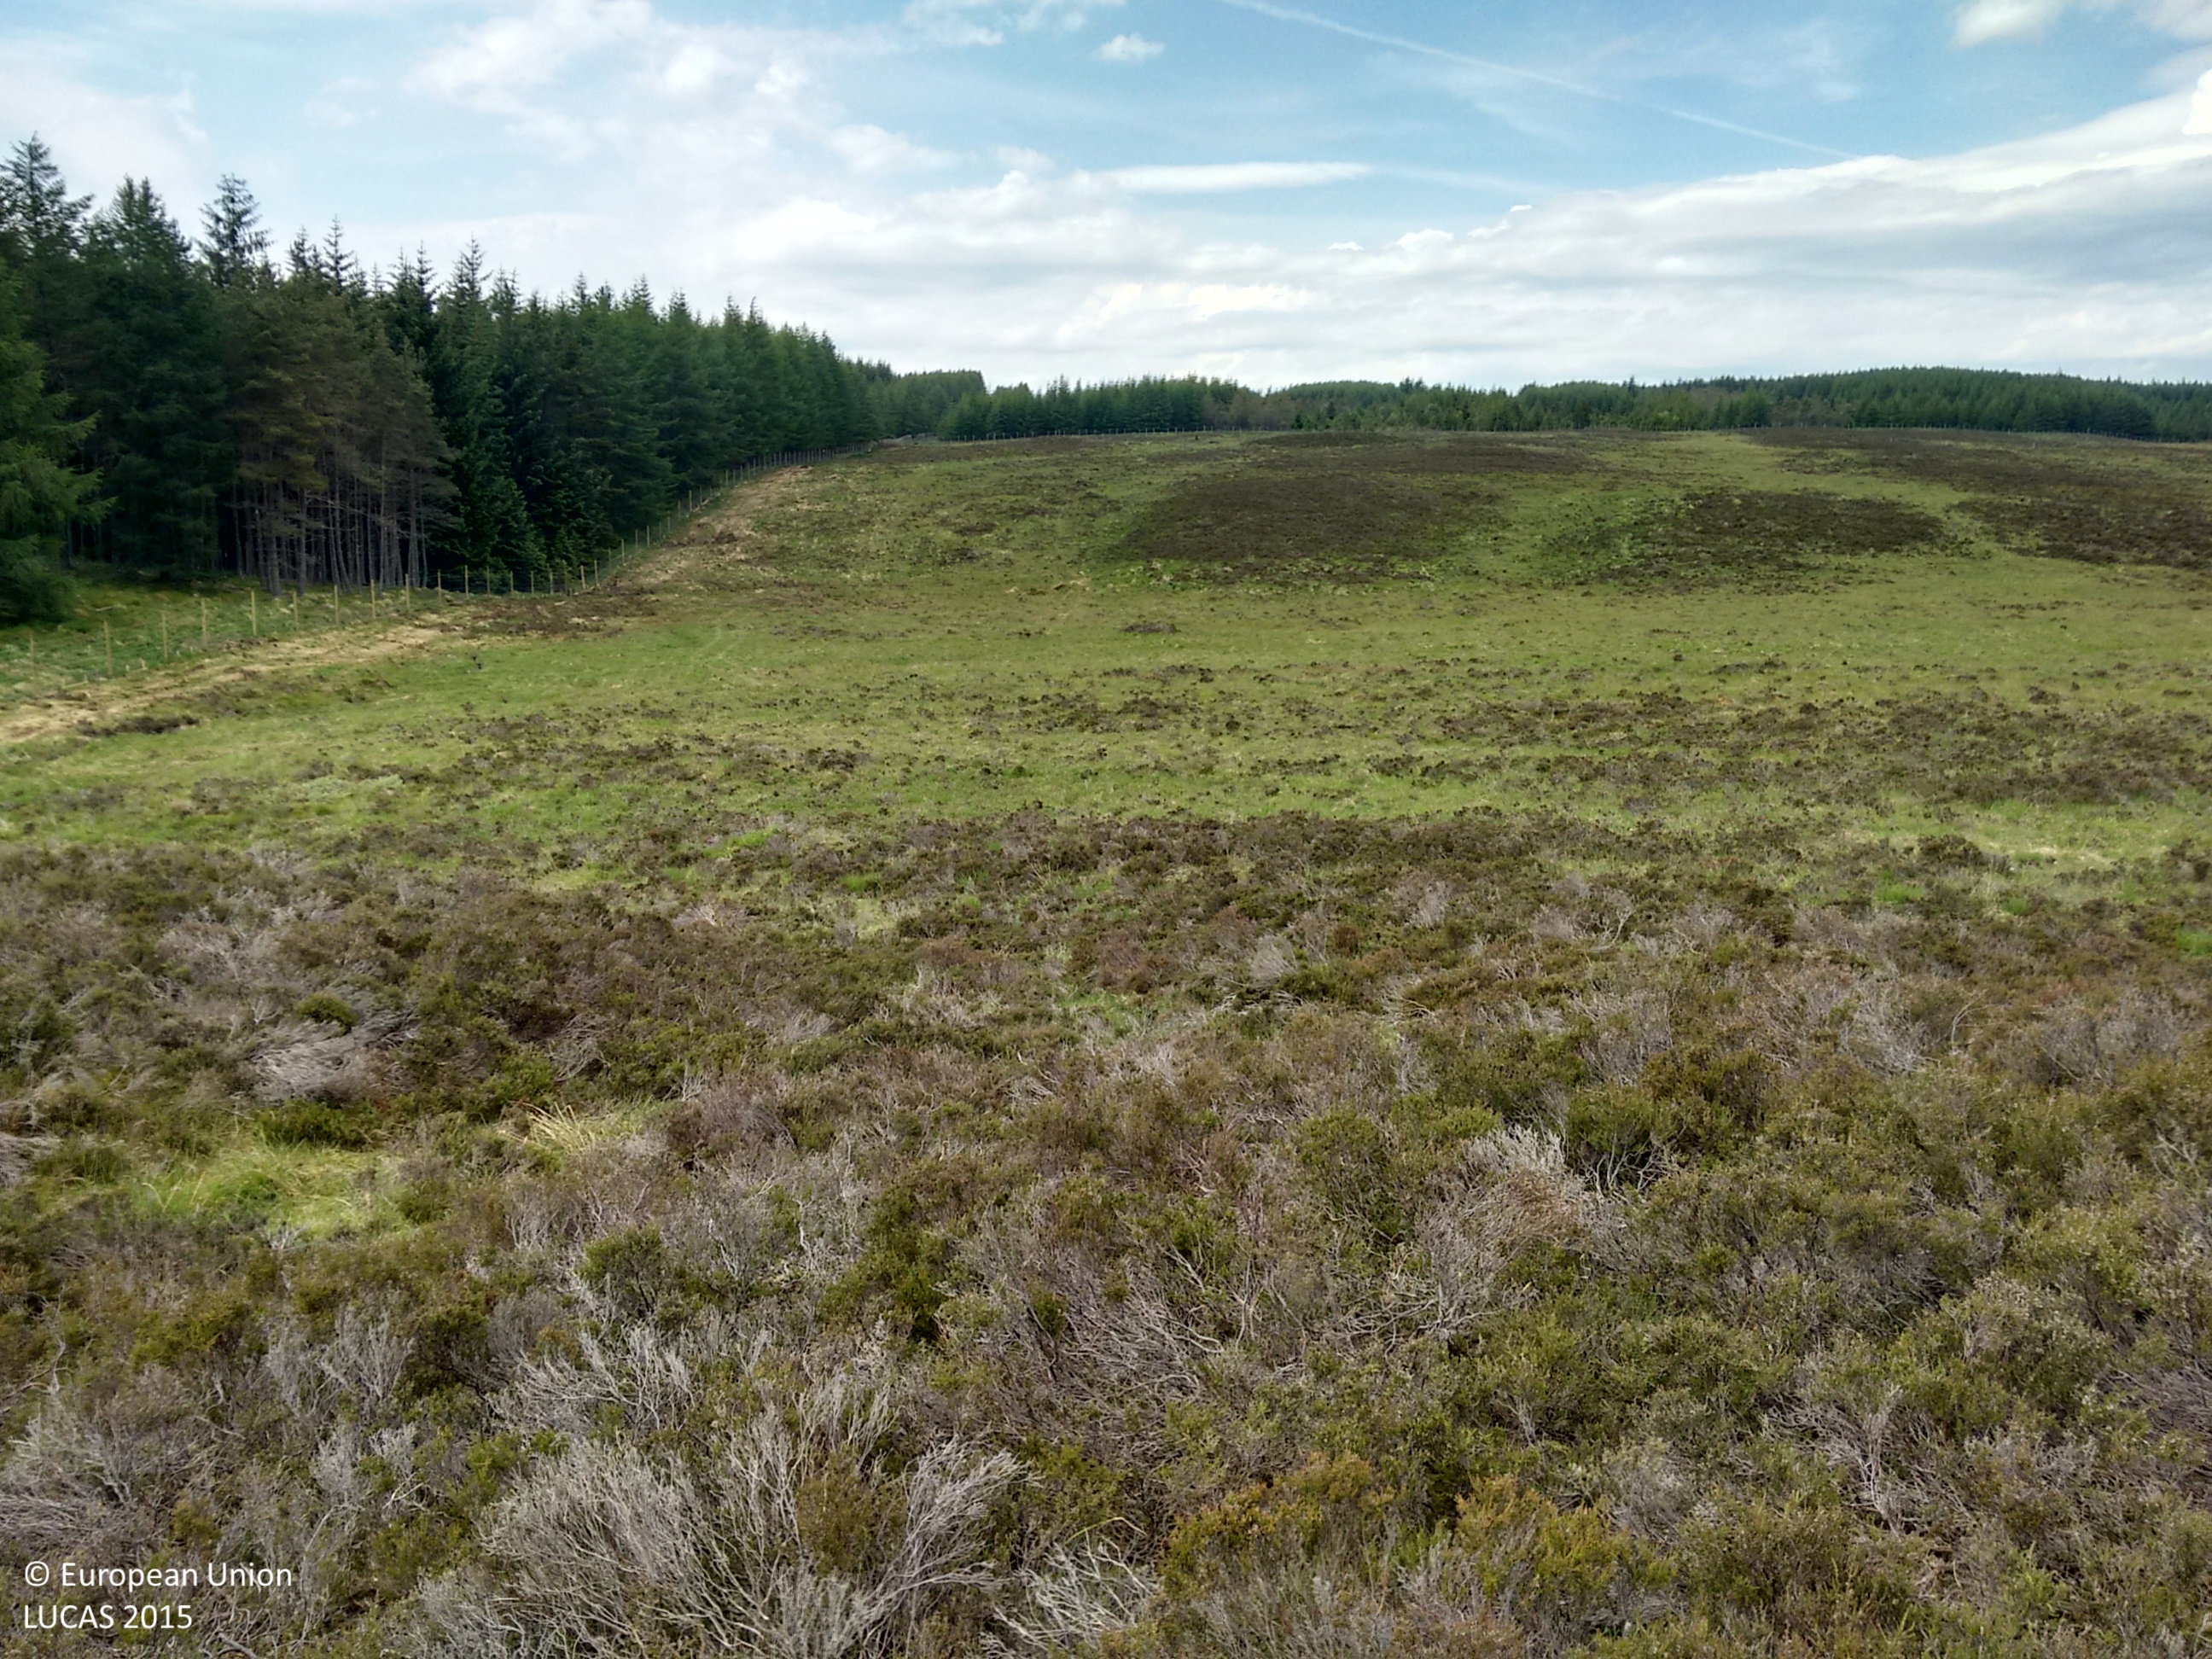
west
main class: Shrubland
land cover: Shrubland without tree cover
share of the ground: > 75 %
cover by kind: shrubs 95 %, herbaceous plants 5 %
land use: Semi-natural and natural areas not in use
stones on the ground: < 10 %
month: July
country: GB
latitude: 56.7391
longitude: -3.9297
